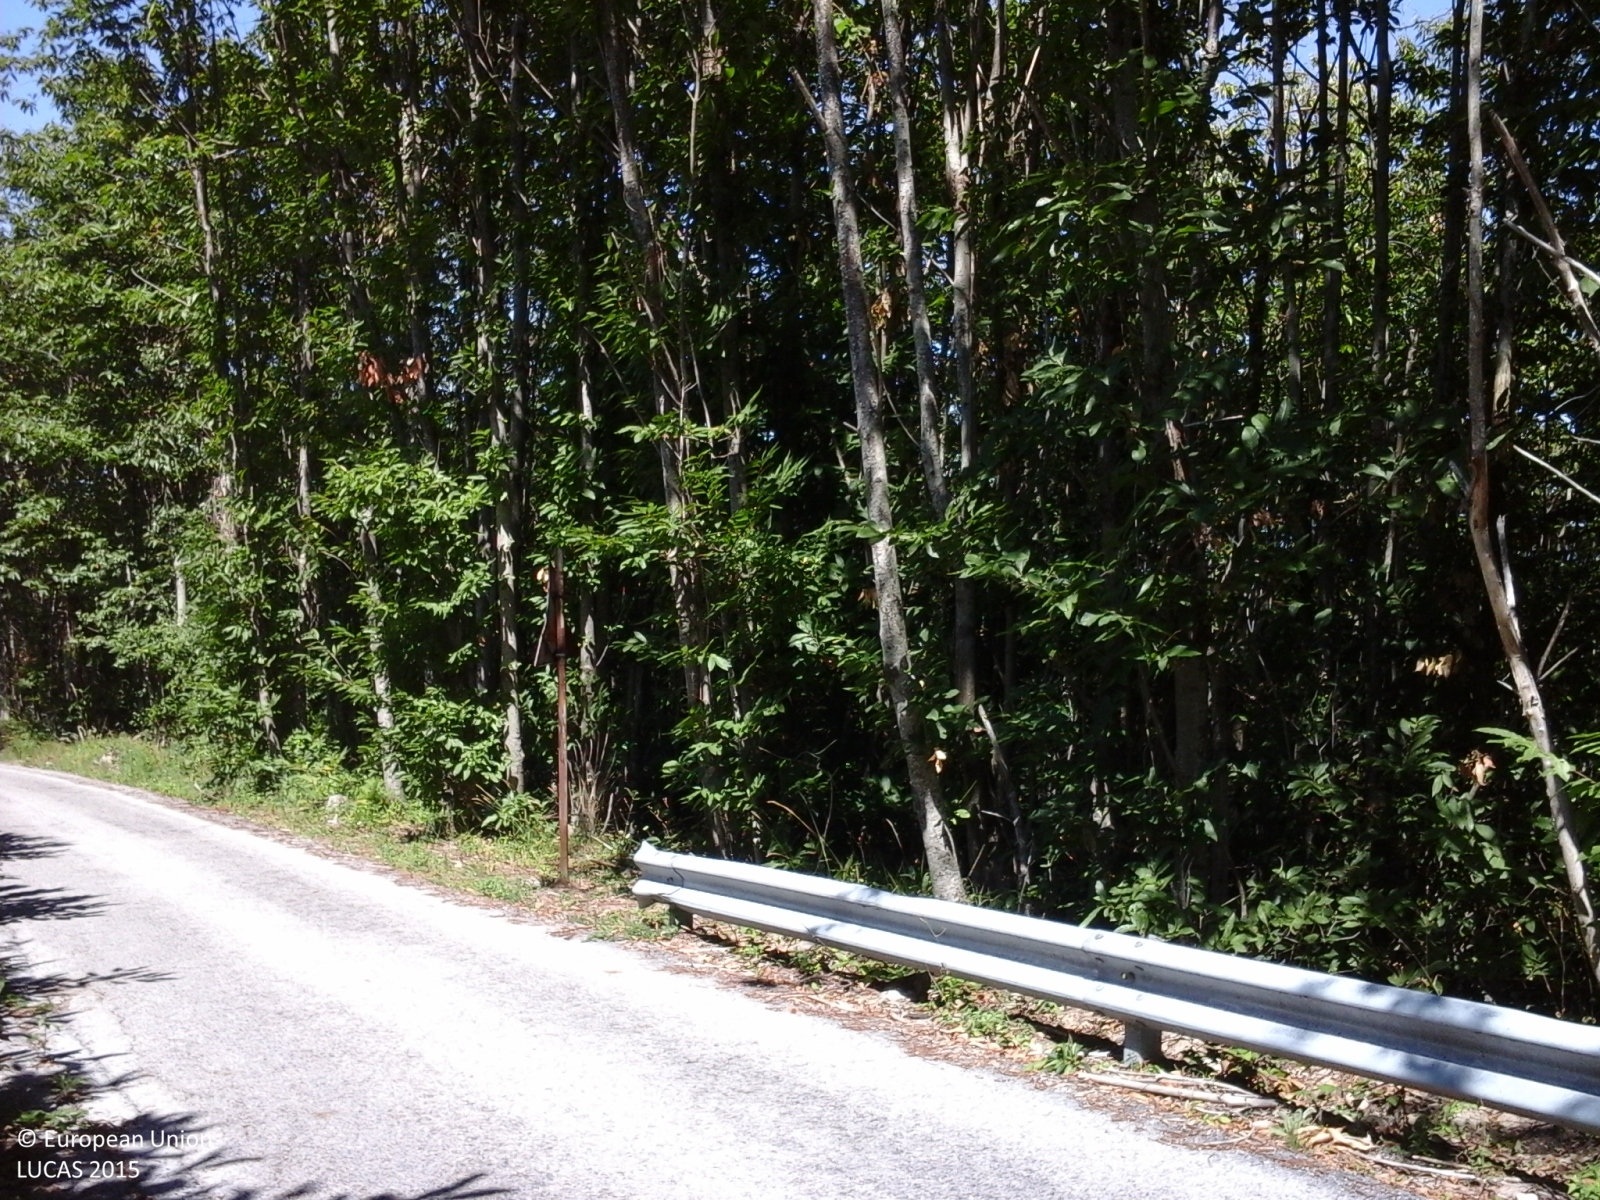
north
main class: Woodland
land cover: Broadleaved woodland
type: thermophilous deciduous forest
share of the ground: > 75 %
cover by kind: broadleaved forest trees 100 %
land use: Forestry
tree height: > 5 m
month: August
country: IT
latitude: 40.2451
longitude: 15.0675
